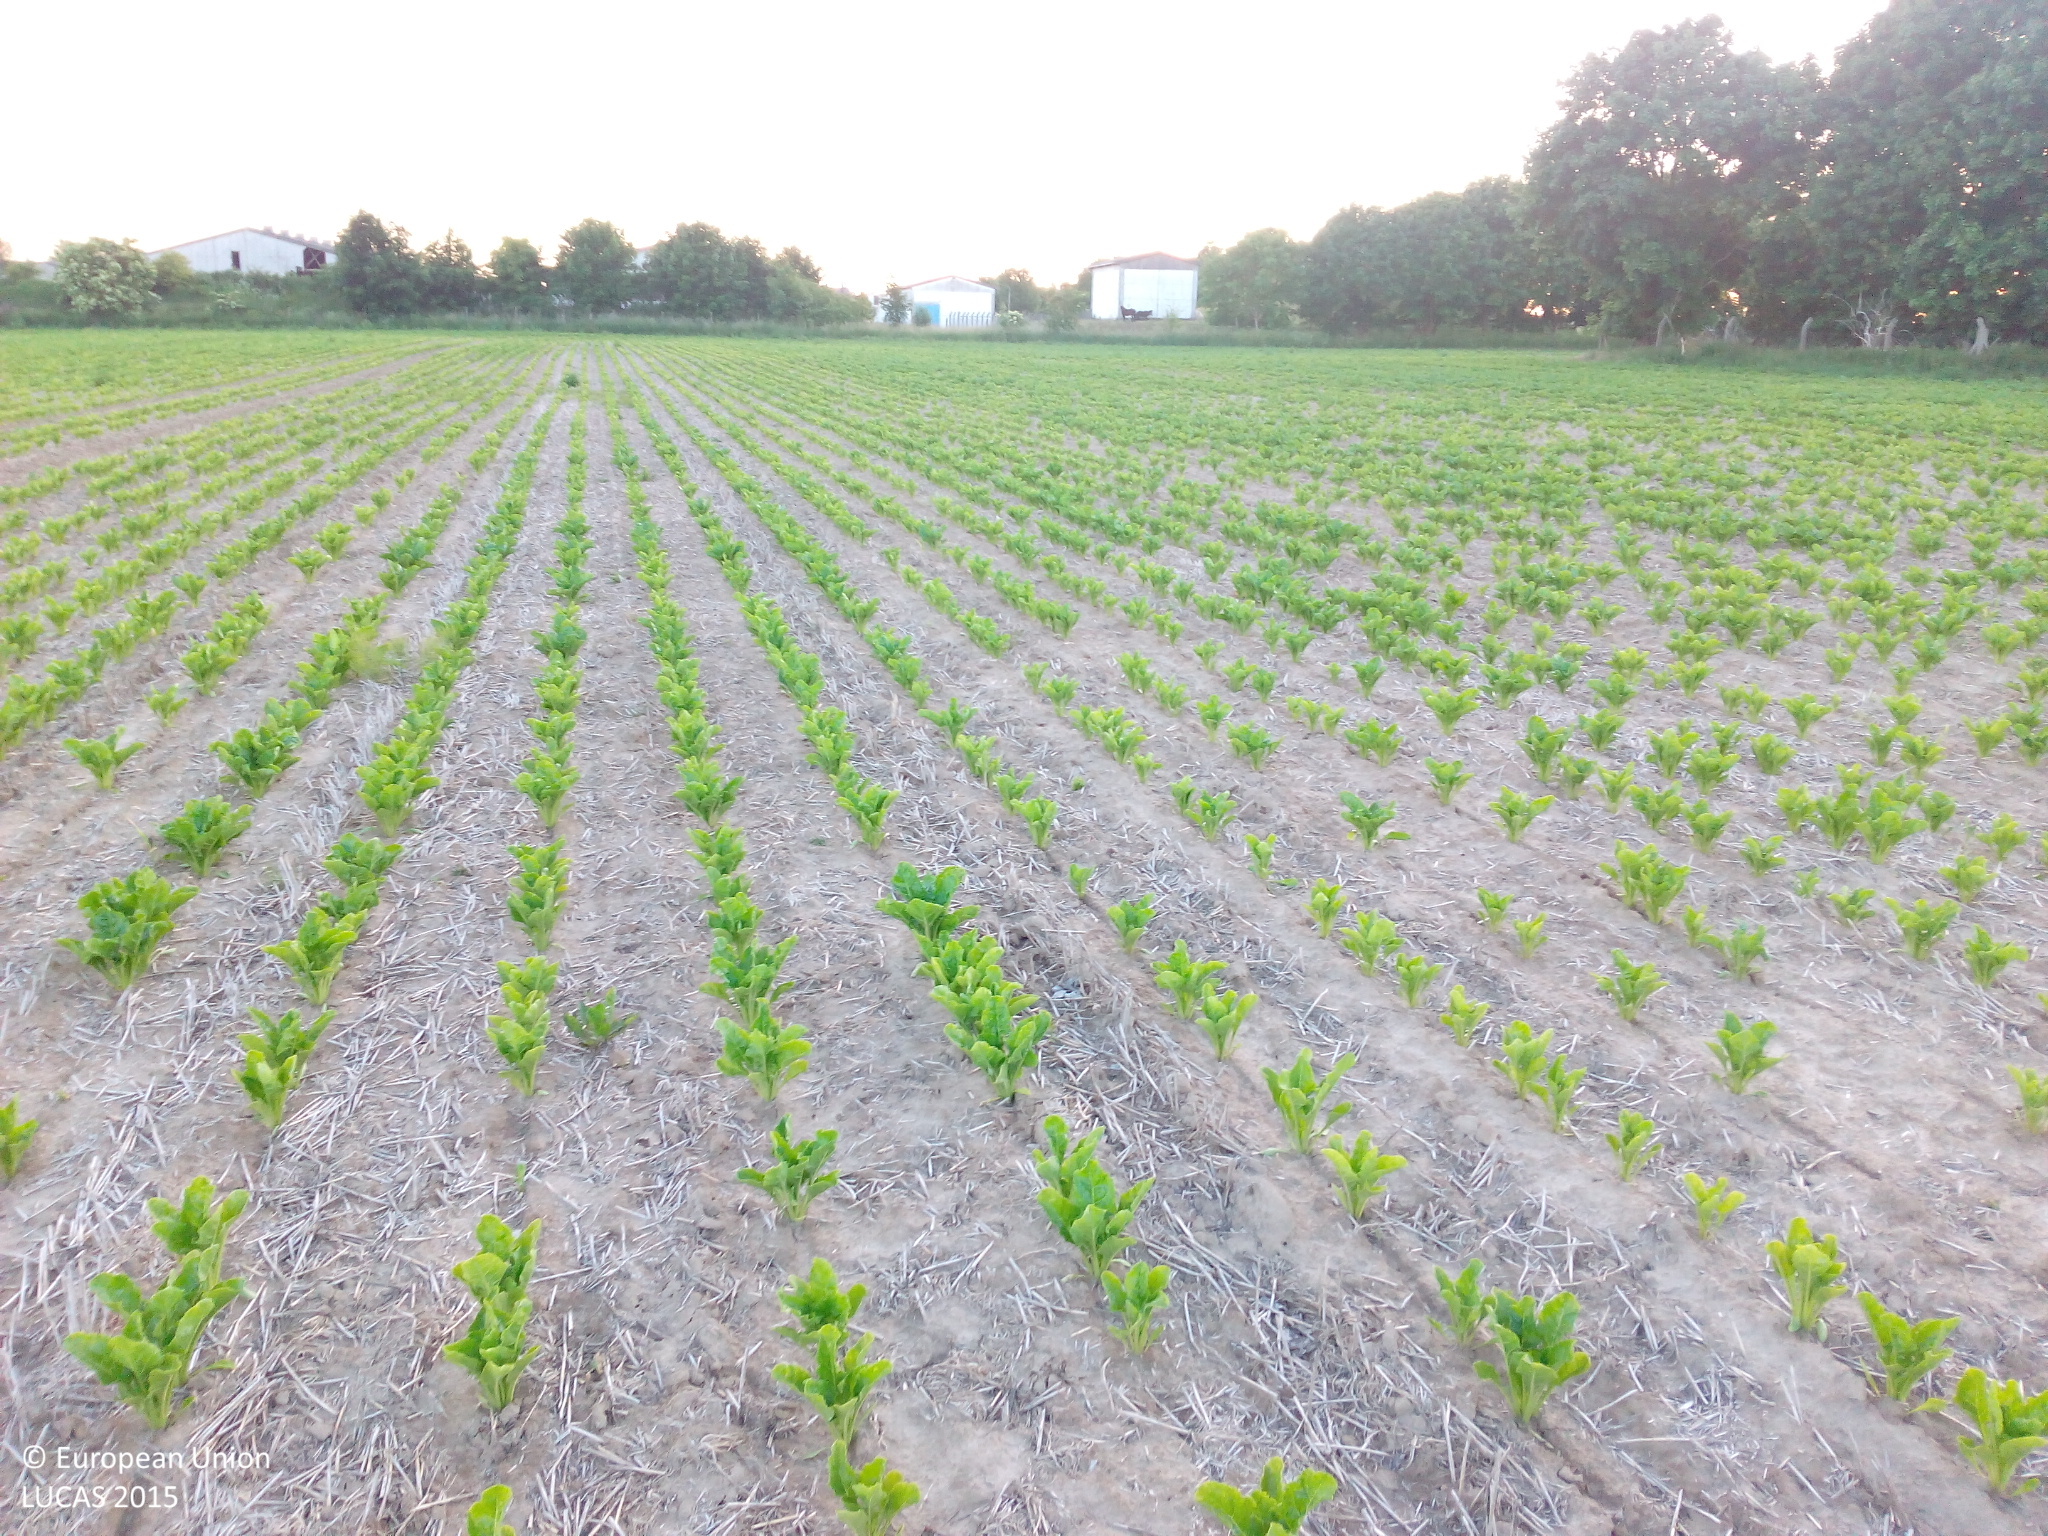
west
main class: Cropland
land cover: Sugar beet
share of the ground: < 10 %
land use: Agriculture (excluding fallow land and kitchen gardens)
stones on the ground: < 10 %
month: June
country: DE
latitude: 53.7019
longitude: 11.1658
